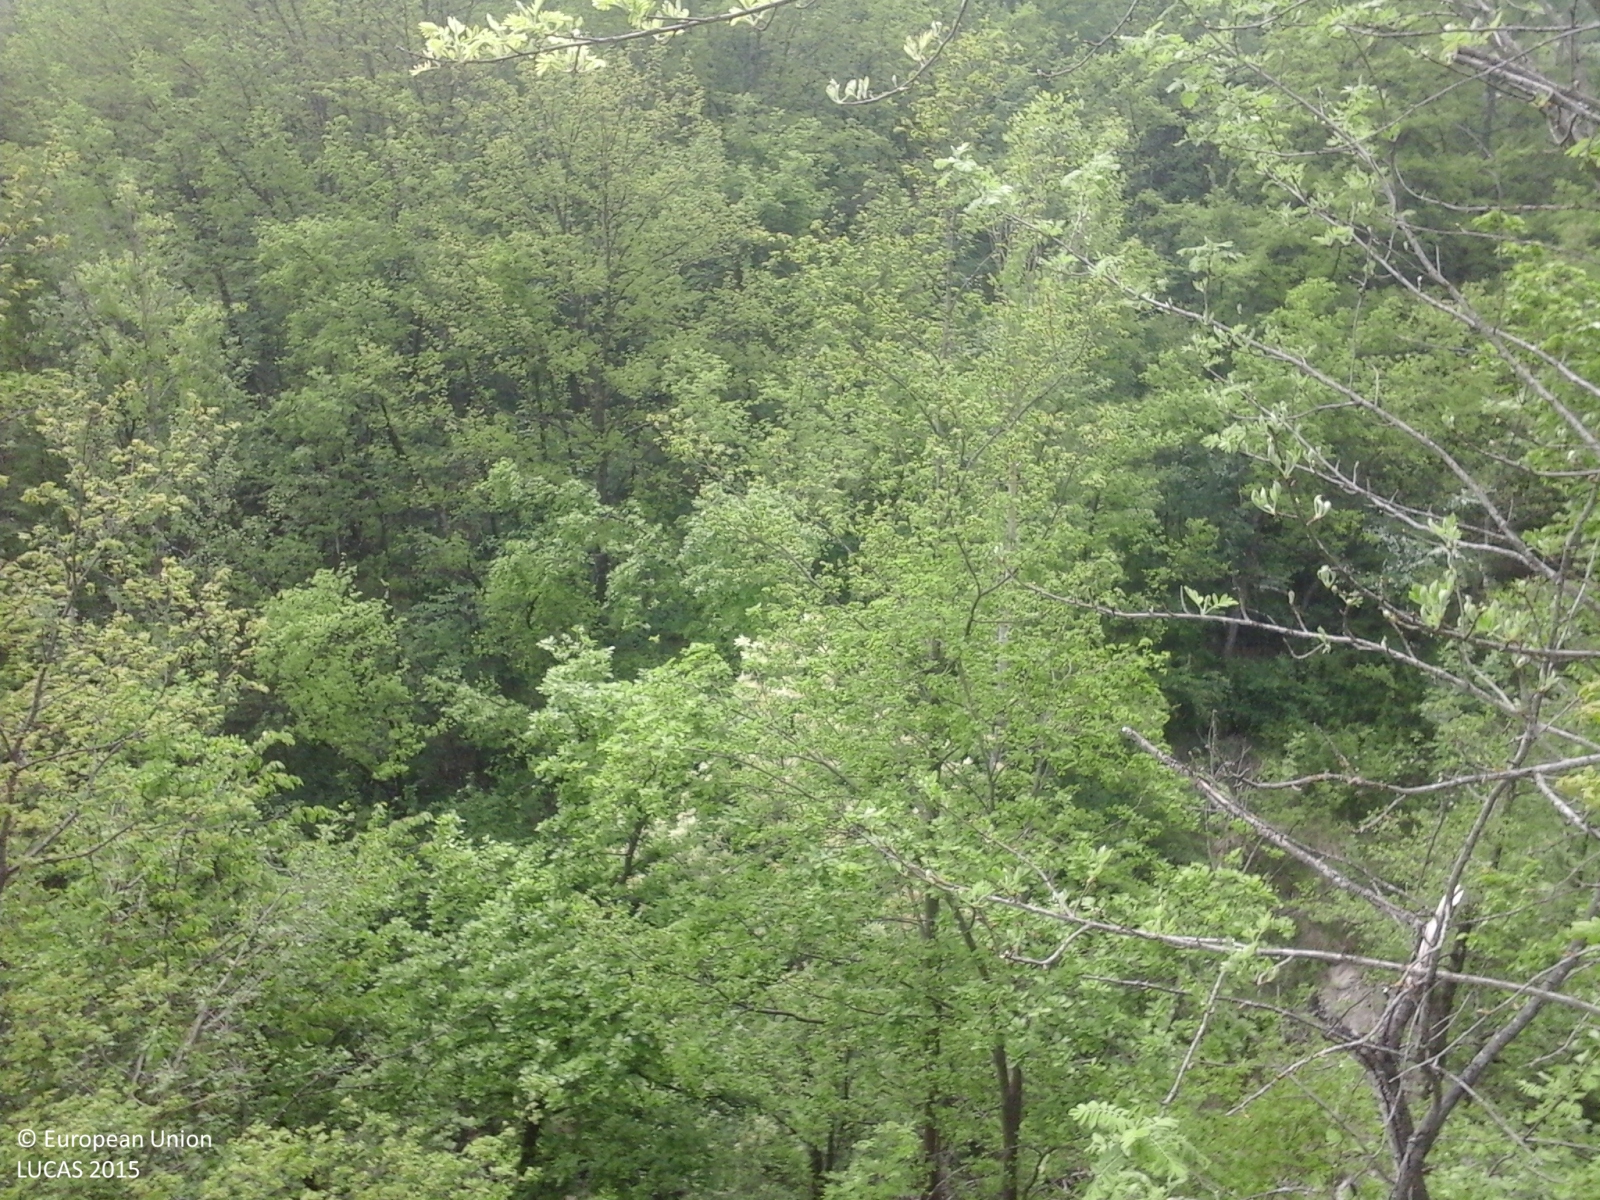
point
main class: Woodland
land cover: Broadleaved woodland
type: thermophilous deciduous forest
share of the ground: > 75 %
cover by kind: broadleaved forest trees 100 %
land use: Forestry
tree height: > 5 m
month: May
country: IT
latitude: 44.3634
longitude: 11.0391
